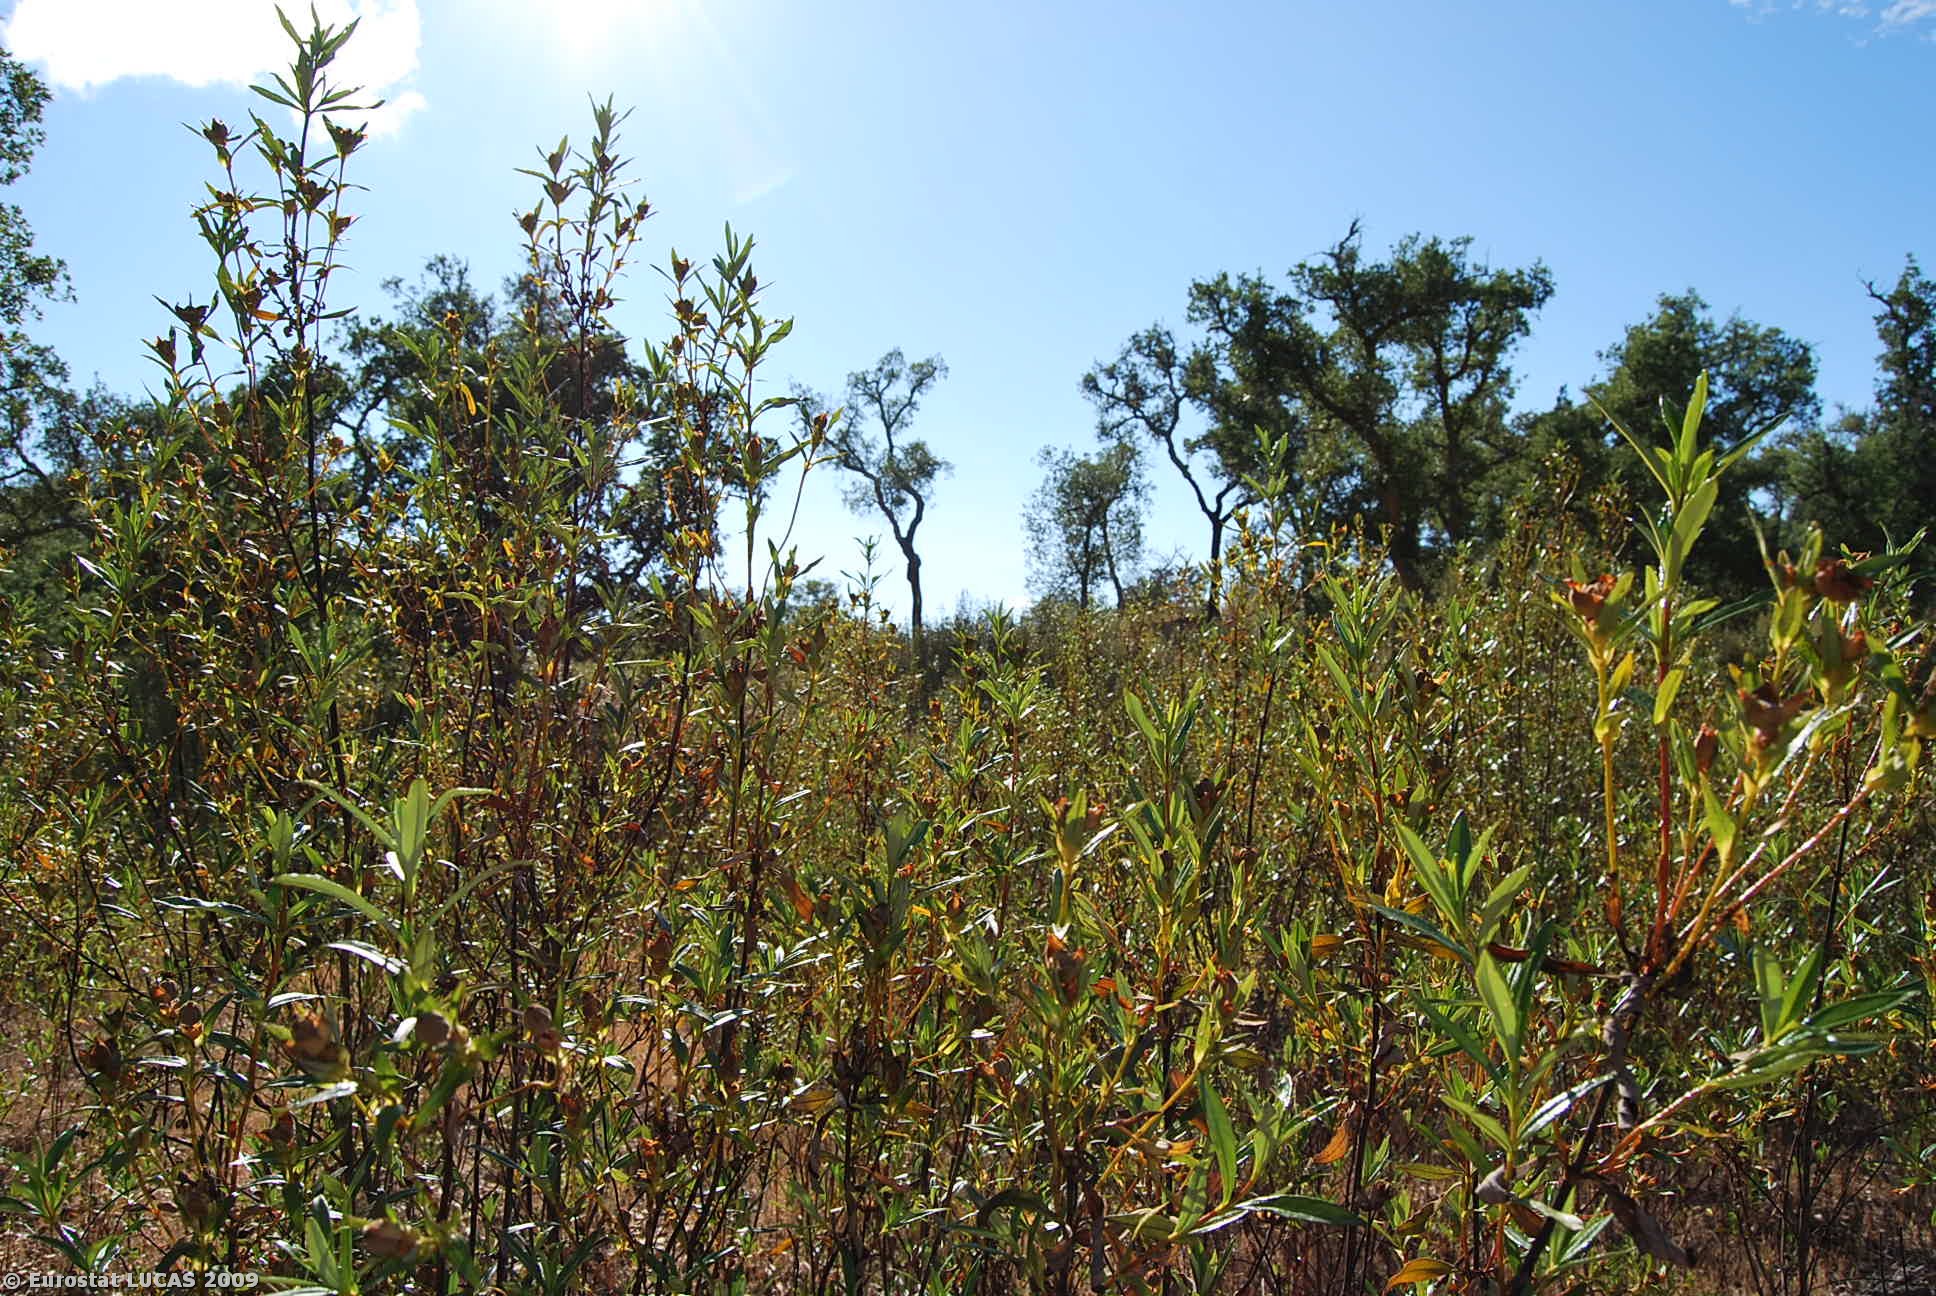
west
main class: Shrubland
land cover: Shrubland with sparse tree cover
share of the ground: > 75 %
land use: Unused
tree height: > 5 m
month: June
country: PT
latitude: 37.9511
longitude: -8.6996
